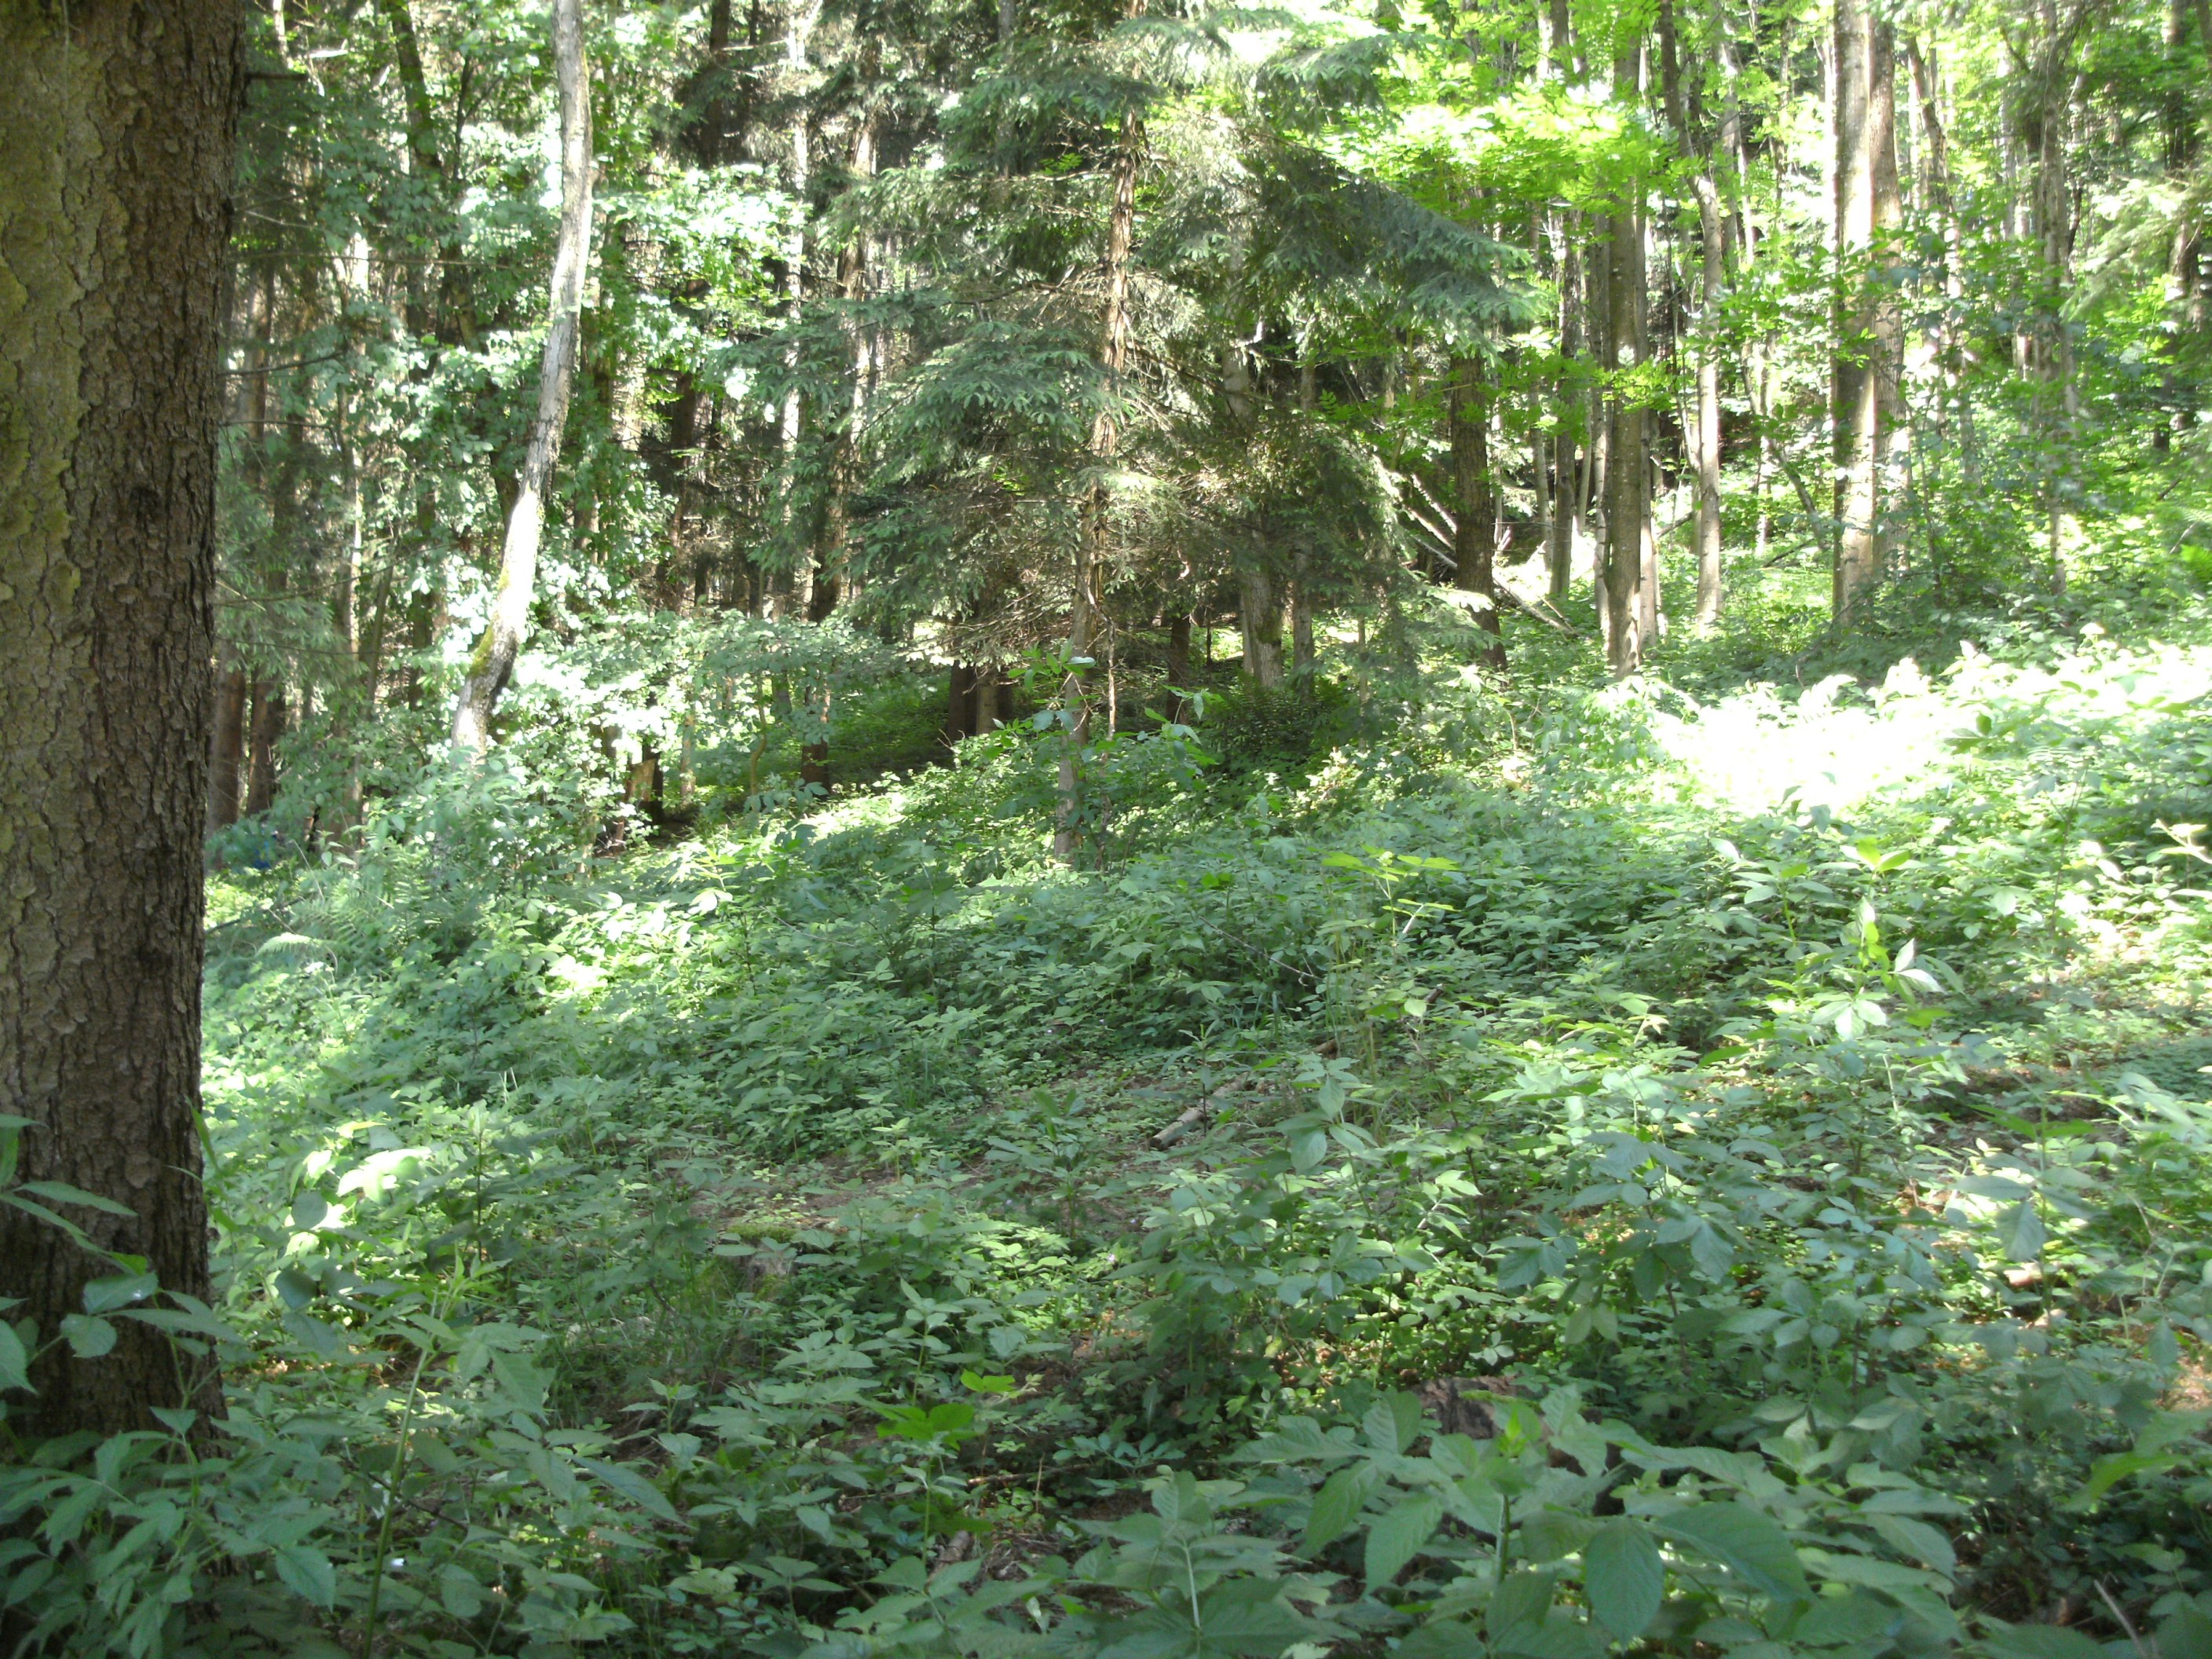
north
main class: Woodland
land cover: Spruce dominated coniferous woodland
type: hemiboreal forest and nemoral coniferous forest and mixed broadleaved-coniferous forest
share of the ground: 50 - 75 %
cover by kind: coniferous forest trees 80 %, herbaceous plants 15 %, shrubs 5 %
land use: Forestry
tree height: > 5 m
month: June
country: AT
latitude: 48.4497
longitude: 14.2050
